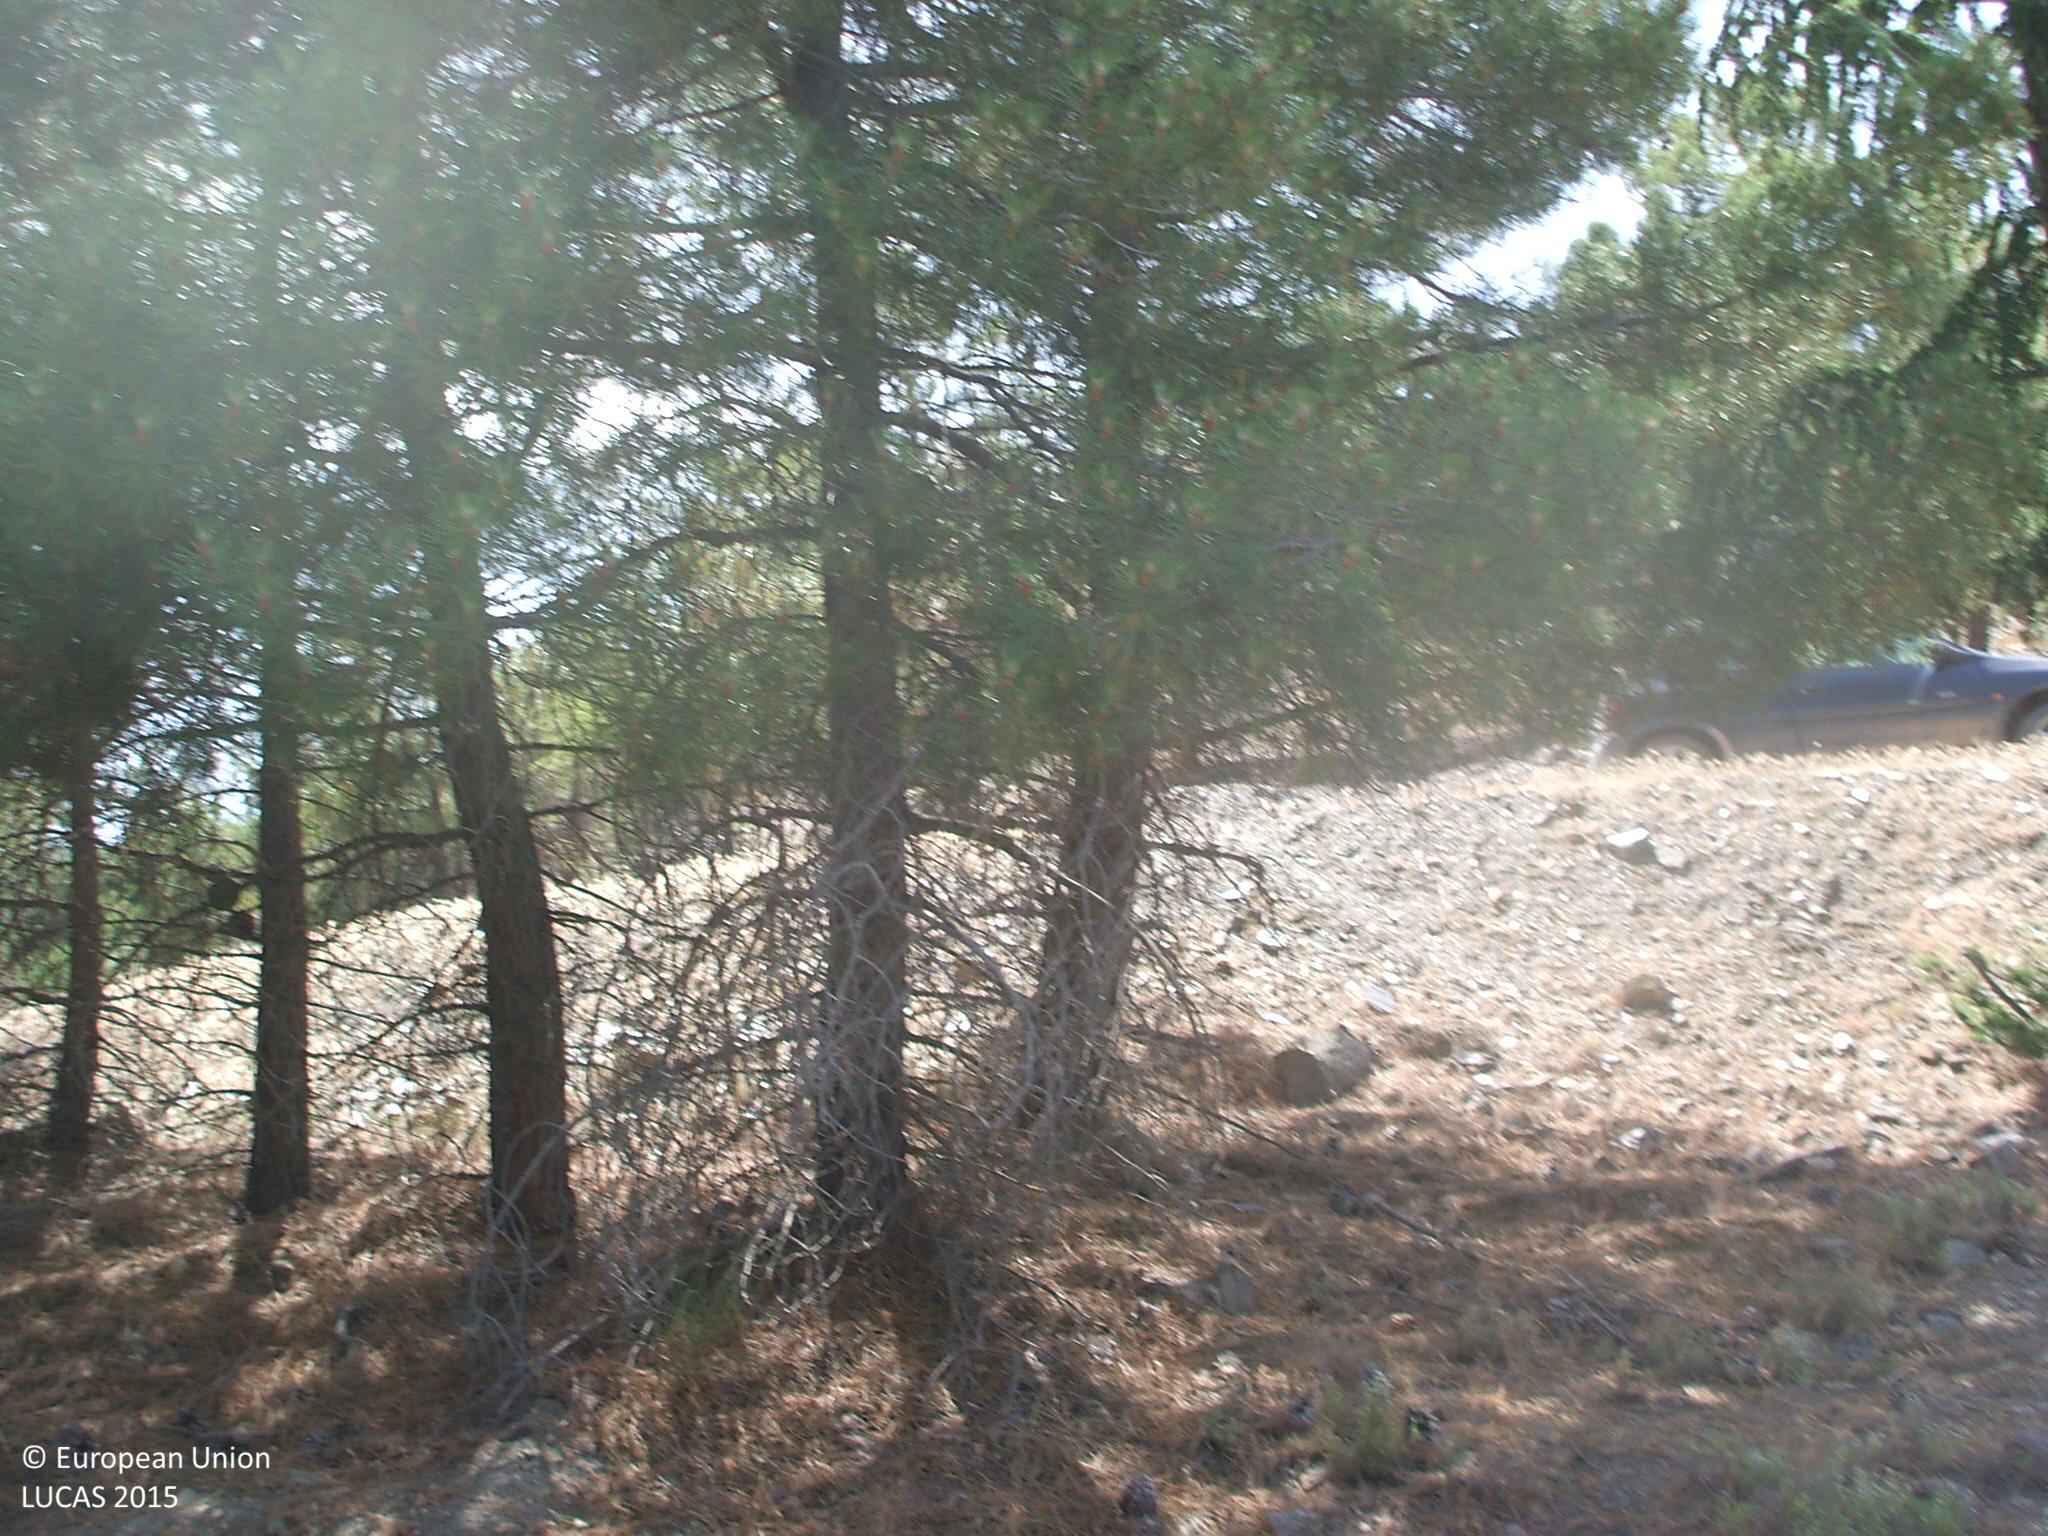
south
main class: Woodland
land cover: Pine dominated coniferous woodland
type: coniferous forest of the mediterranean region
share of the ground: 10 - 25 %
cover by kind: herbaceous plants 40 %, shrubs 30 %, coniferous forest trees 15 %, consolidated bare surface 15 %
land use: Semi-natural and natural areas not in use
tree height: > 5 m
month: July
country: ES
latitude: 37.2663
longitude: -2.6462
